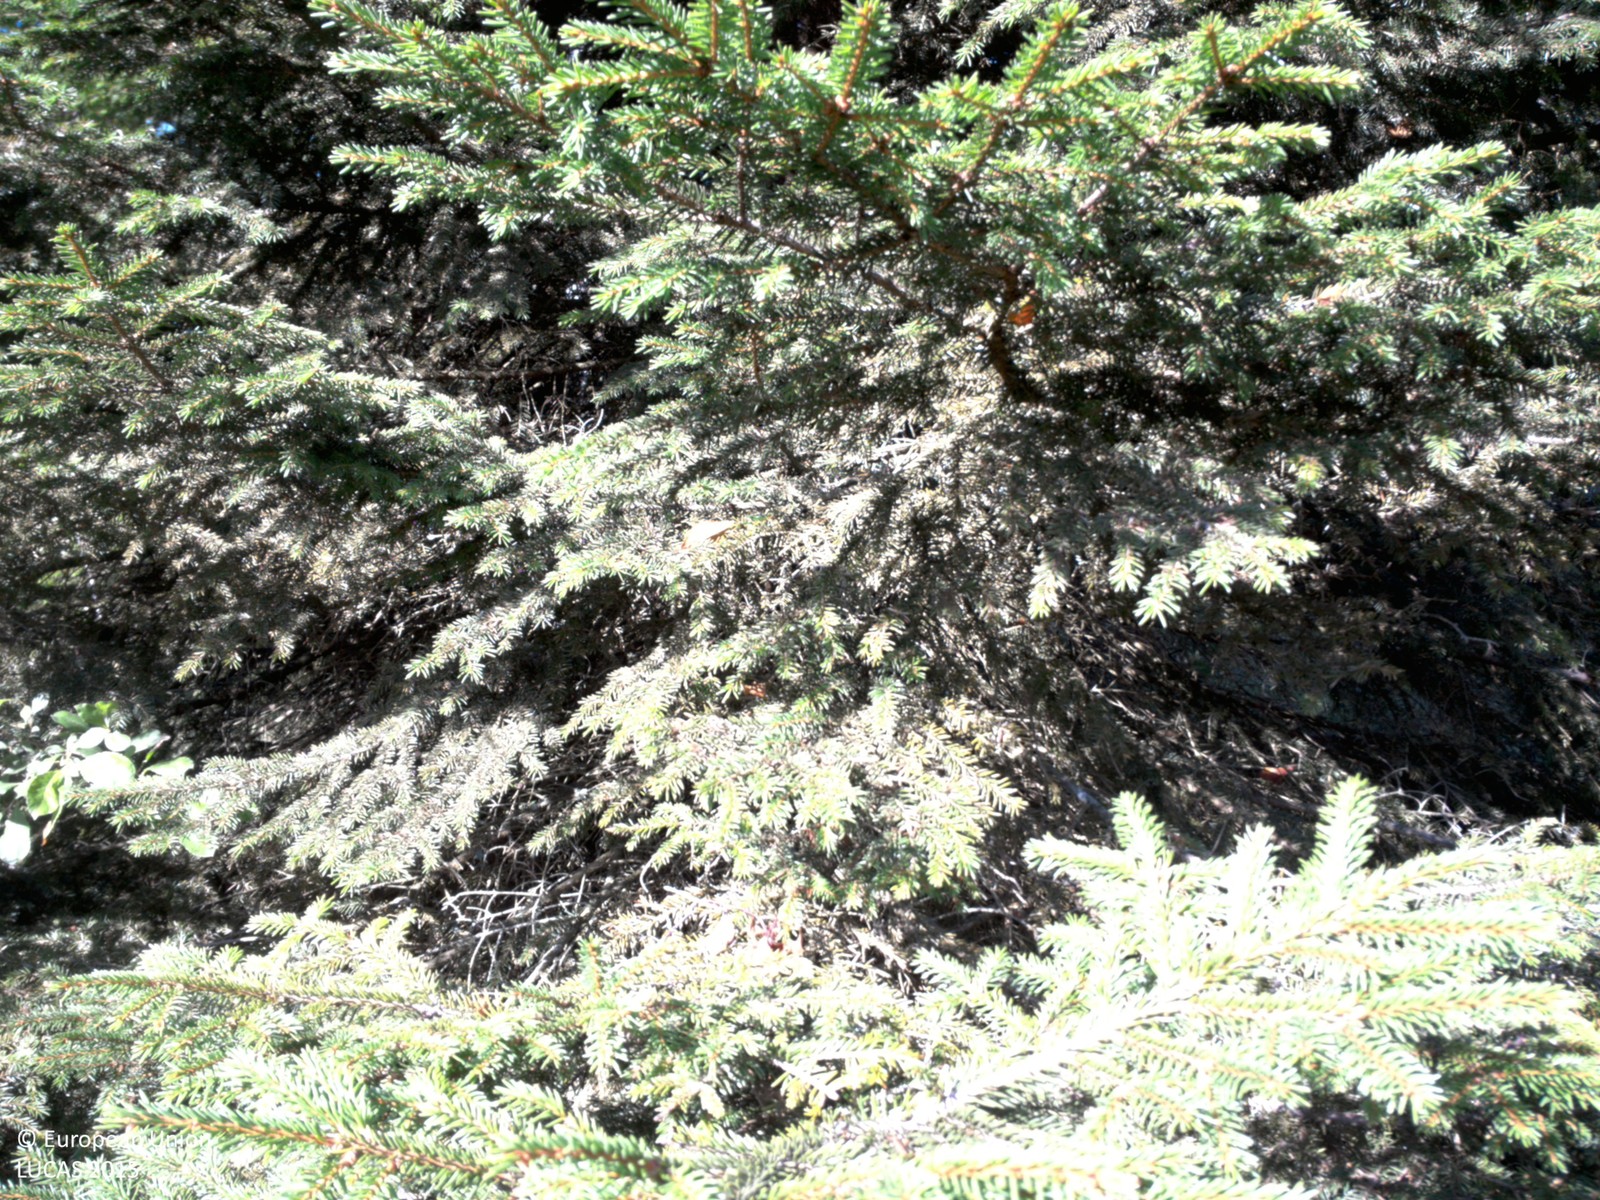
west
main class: Woodland
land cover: Spruce dominated mixed woodland
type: boreal forest
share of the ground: 50 - 75 %
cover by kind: broadleaved forest trees 45 %, lichens and mosses 25 %, coniferous forest trees 15 %, shrubs 15 %
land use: Electricity, gas and thermal power distribution
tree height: < 5 m
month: August
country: SE
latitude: 58.0213
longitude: 12.2138
